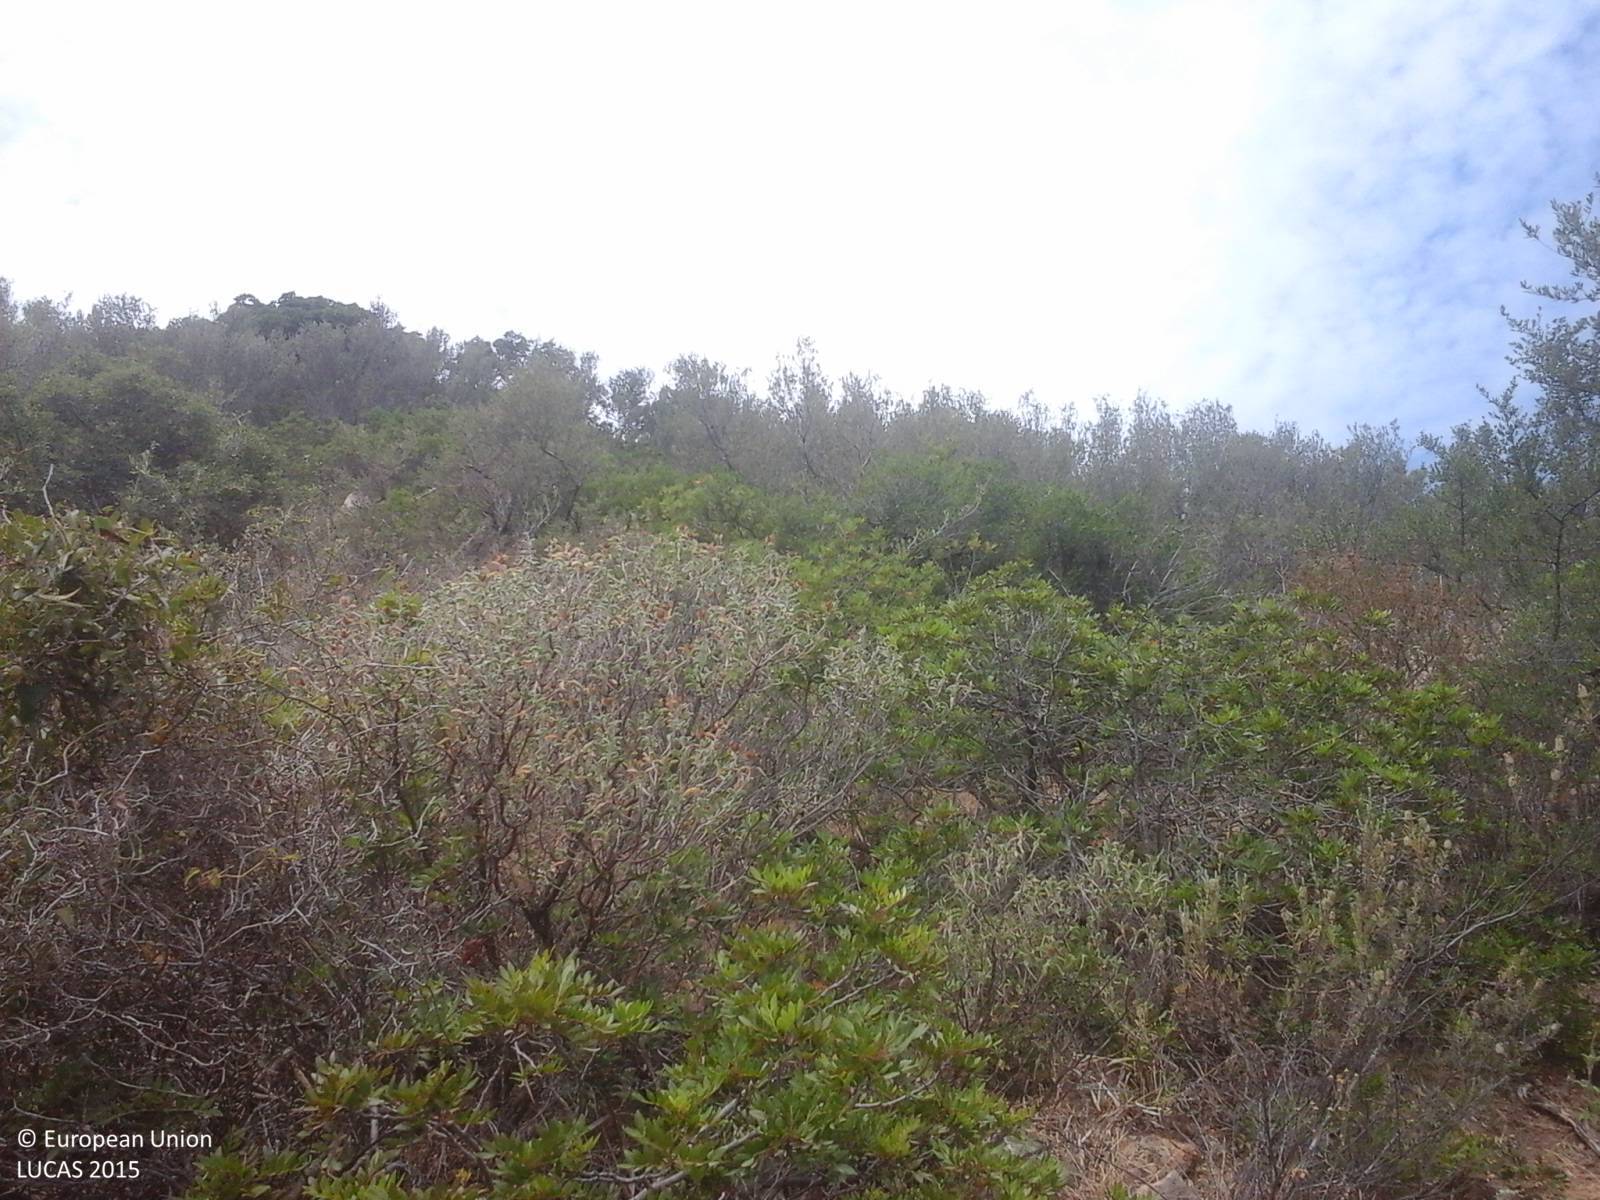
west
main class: Shrubland
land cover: Shrubland with sparse tree cover
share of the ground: > 75 %
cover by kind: shrubs 55 %, herbaceous plants 20 %, unconsolidated bare surface 20 %, broadleaved forest trees 5 %
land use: Semi-natural and natural areas not in use
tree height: < 5 m
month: June
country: IT
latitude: 39.3790
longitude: 9.5731
